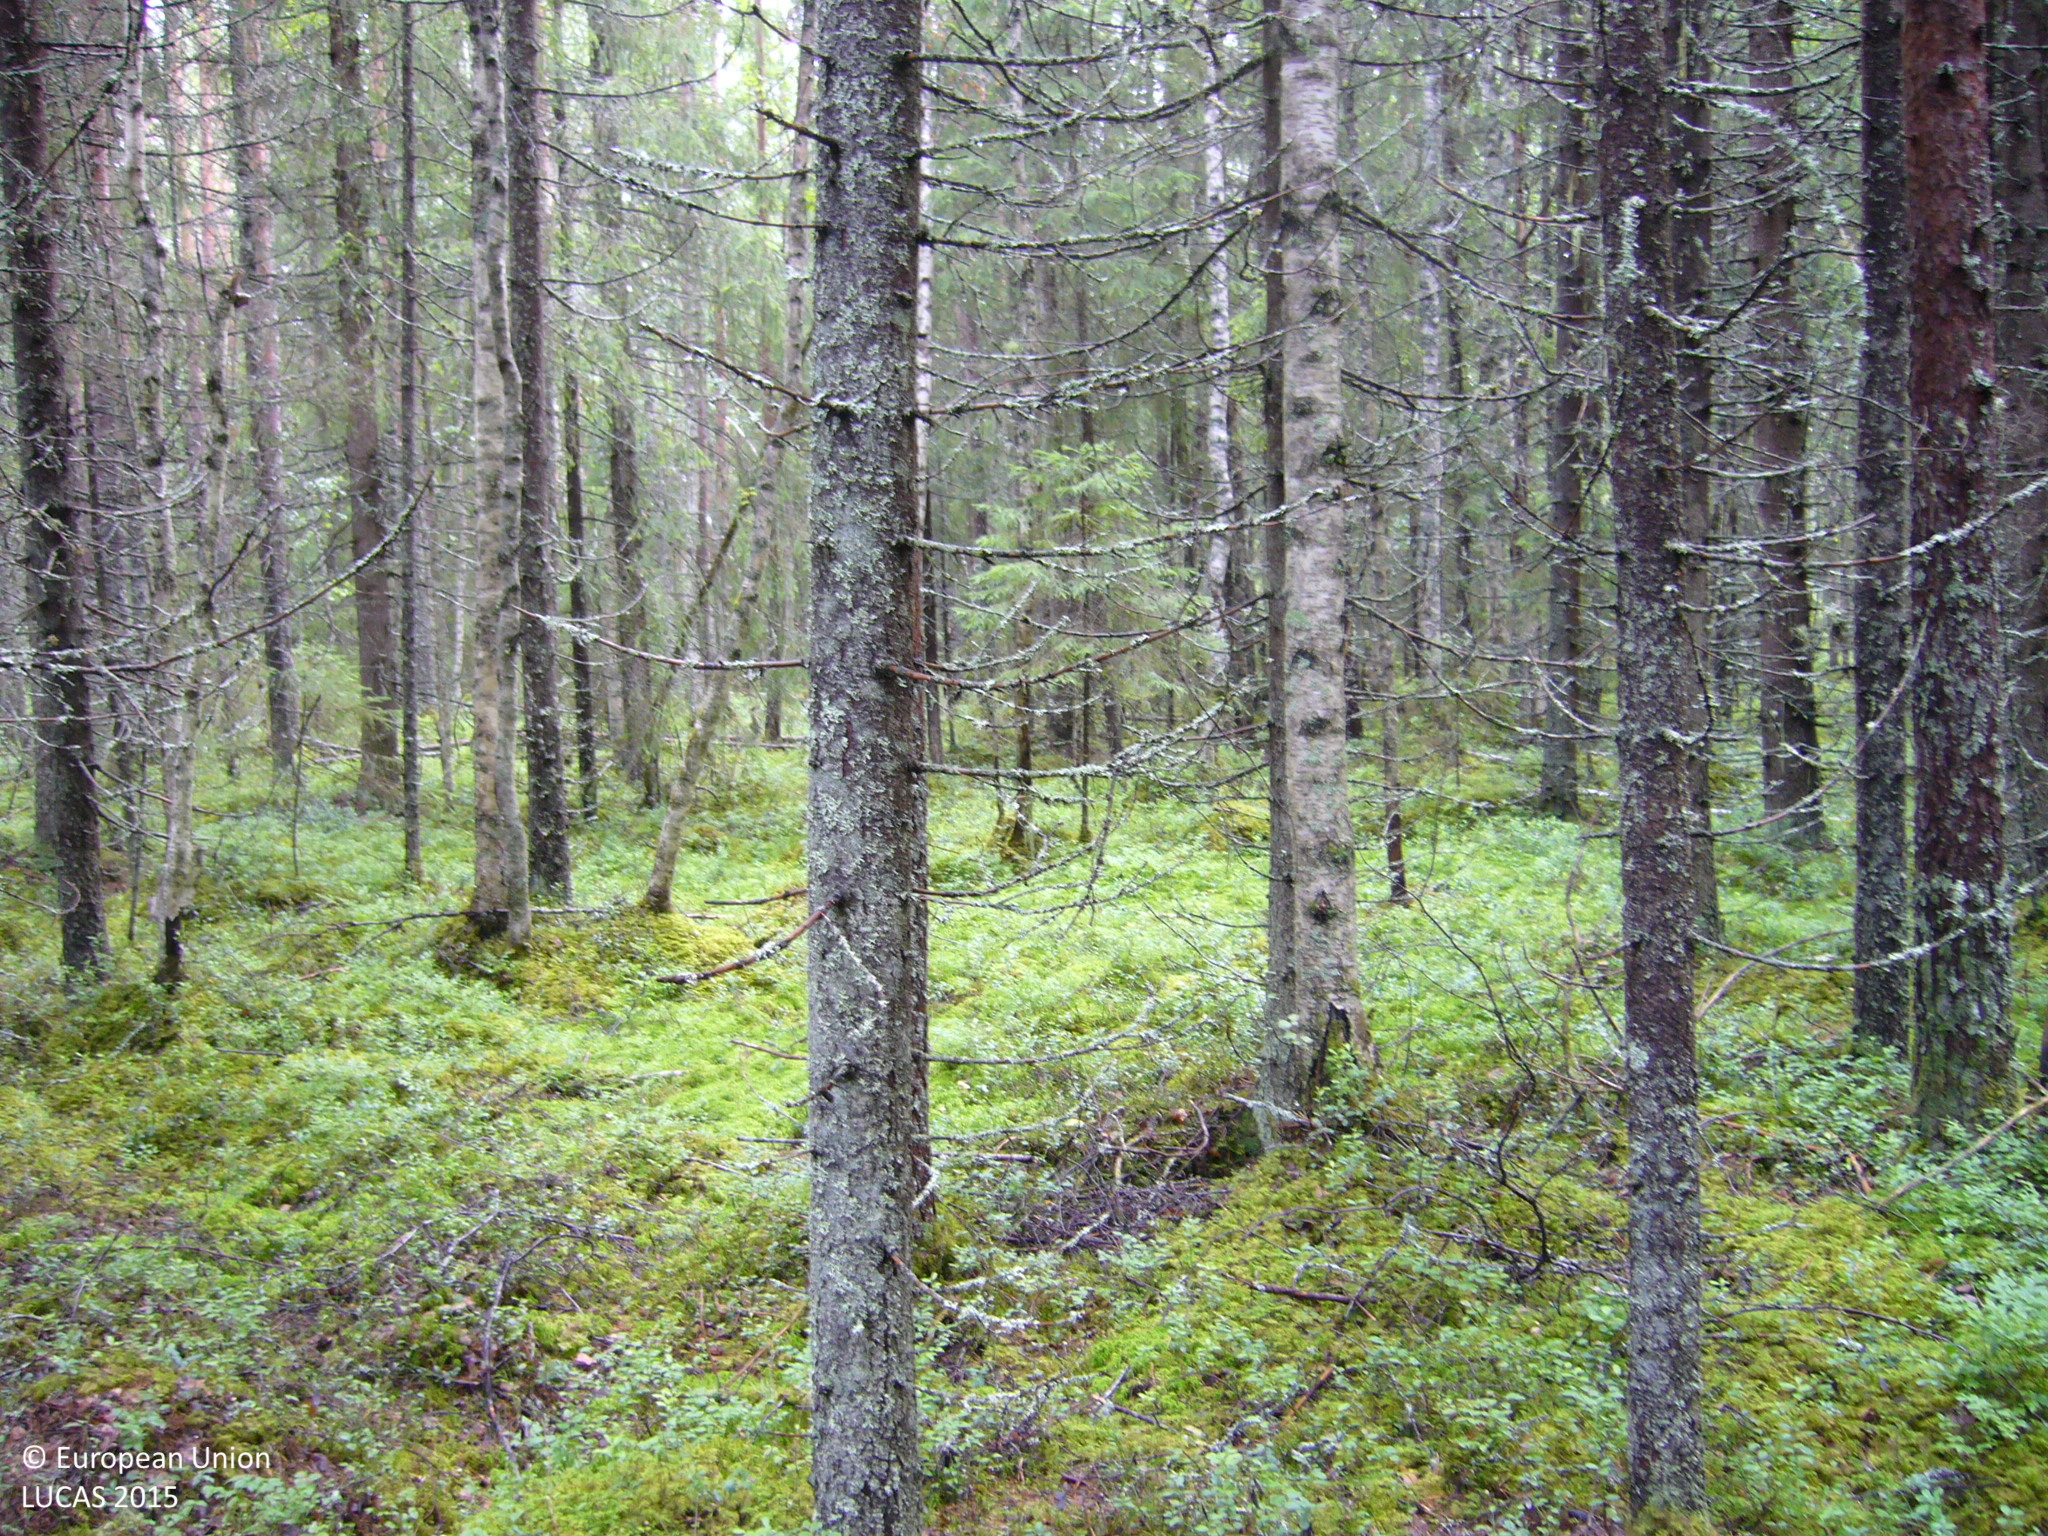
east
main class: Woodland
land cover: Spruce dominated mixed woodland
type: boreal forest
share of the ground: > 75 %
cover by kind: coniferous forest trees 50 %, broadleaved forest trees 30 %, shrubs 20 %
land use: Forestry
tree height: > 5 m
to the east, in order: Spruce dominated mixed woodland; Other mixed woodland; Ditches and canals; Other mixed woodland; Spontaneously vegetated surfaces; Electric lines; Spontaneously vegetated surfaces; Electric lines; Grassland without tree/shrub cover; Artificial constructions in urban areas; Grassland without tree/shrub cover
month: July
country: FI
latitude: 63.8832
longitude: 25.5523
